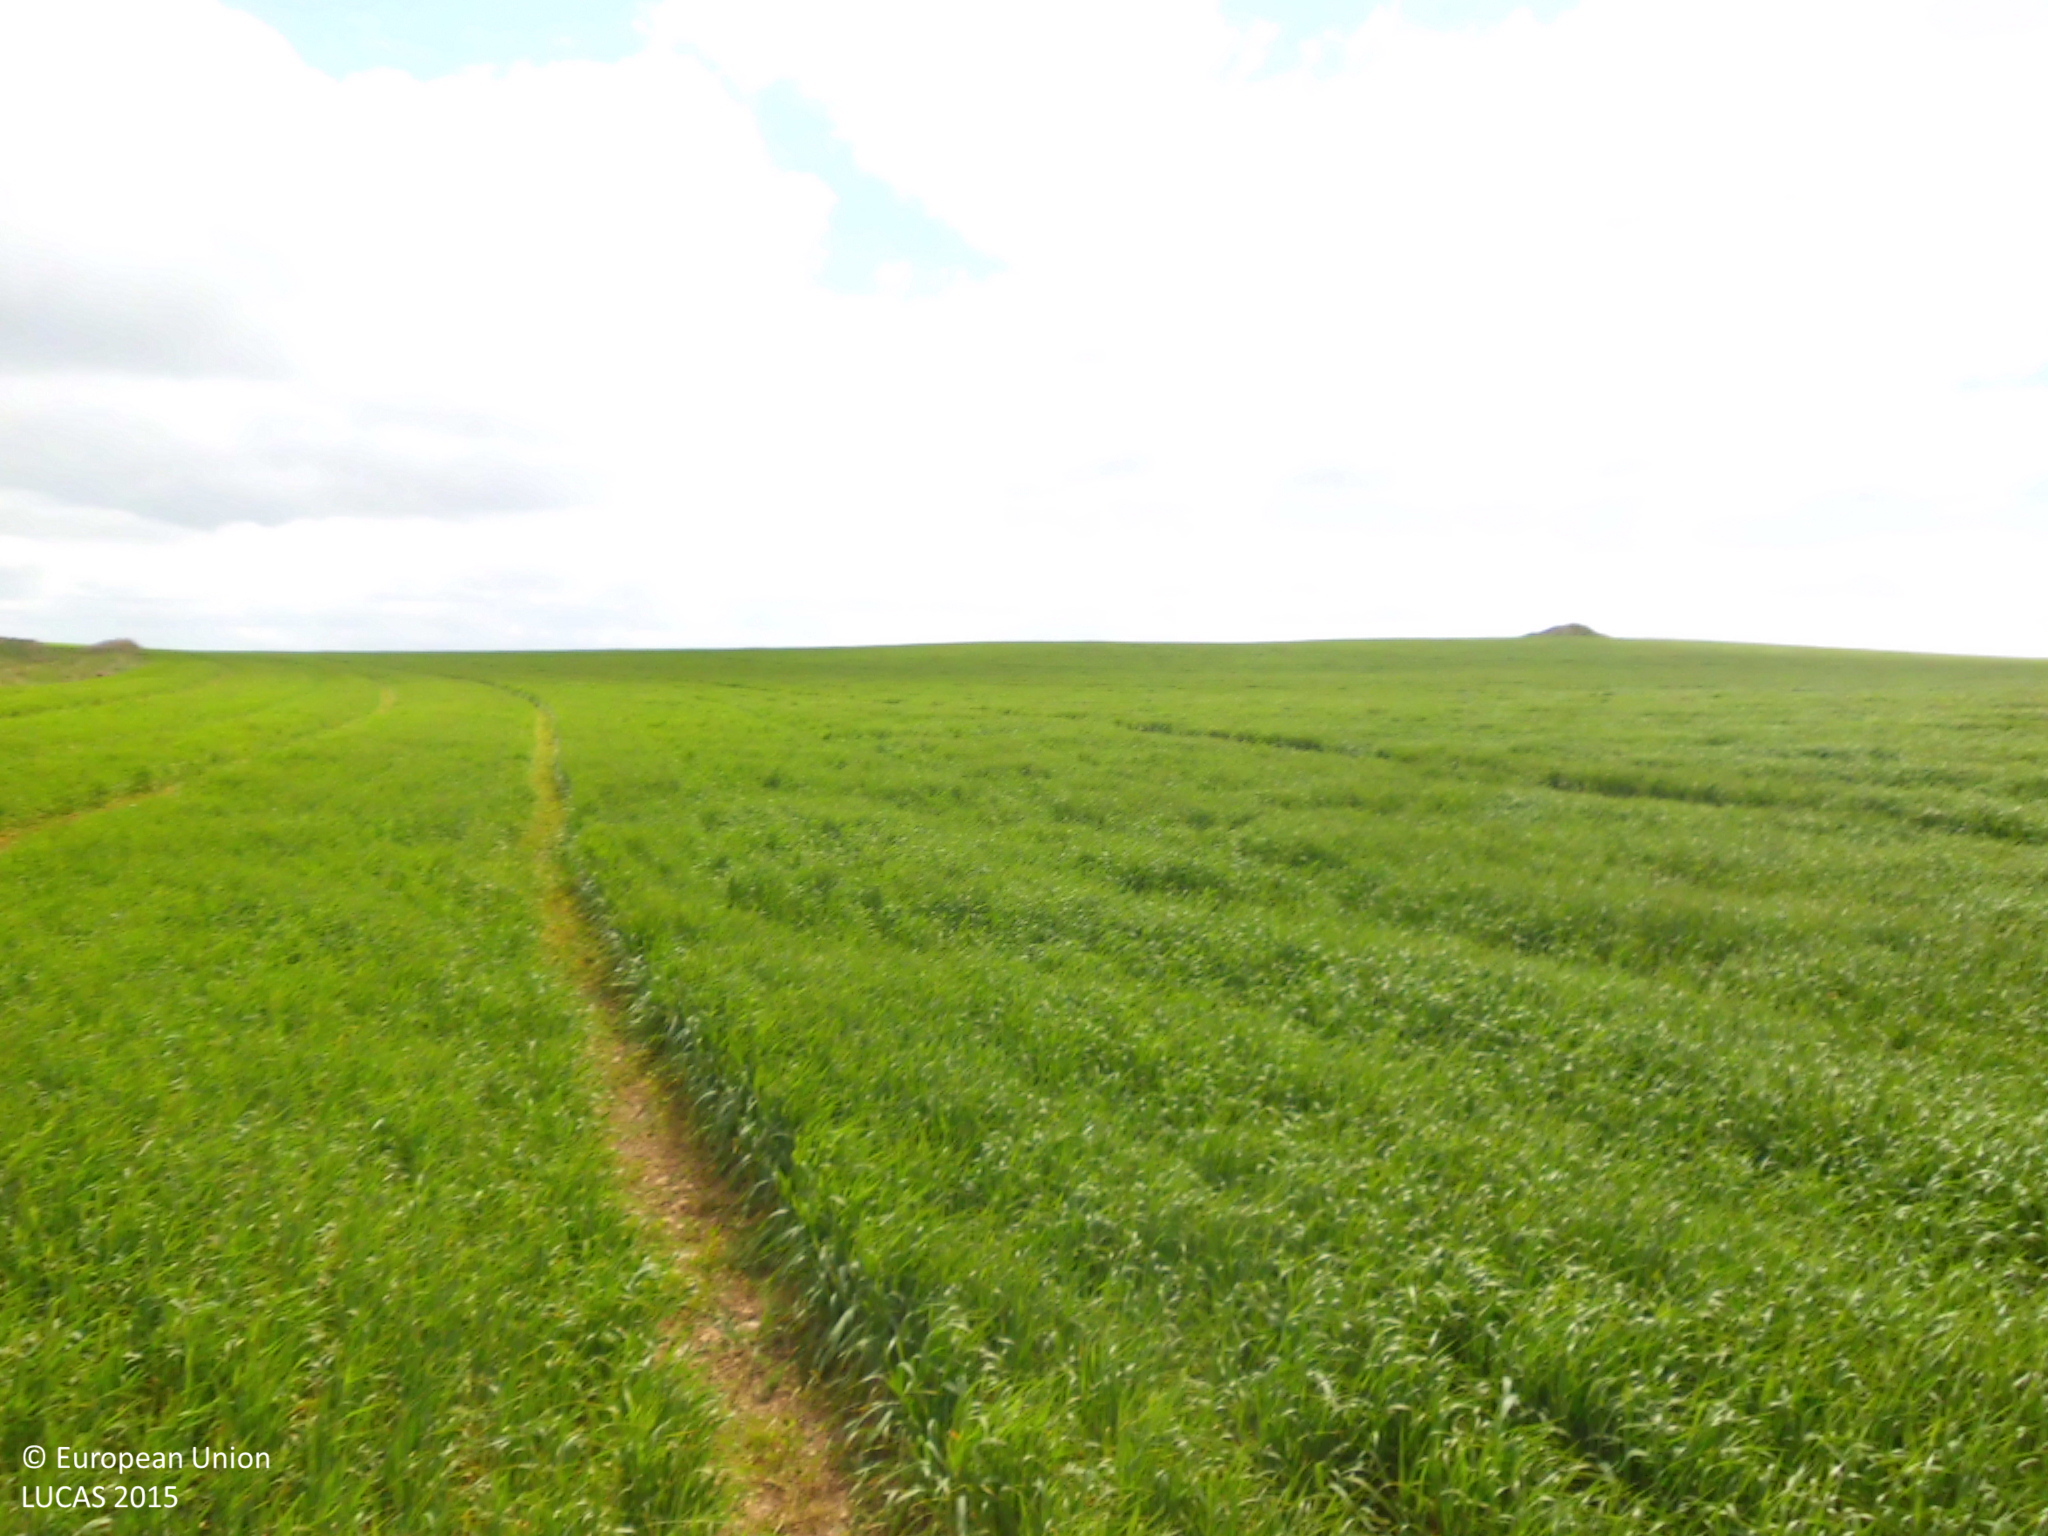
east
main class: Cropland
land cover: Barley
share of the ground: > 75 %
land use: Agriculture (excluding fallow land and kitchen gardens)
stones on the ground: 10 - 25 %
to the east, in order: Barley
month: May
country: ES
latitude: 42.3648
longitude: -3.9186
